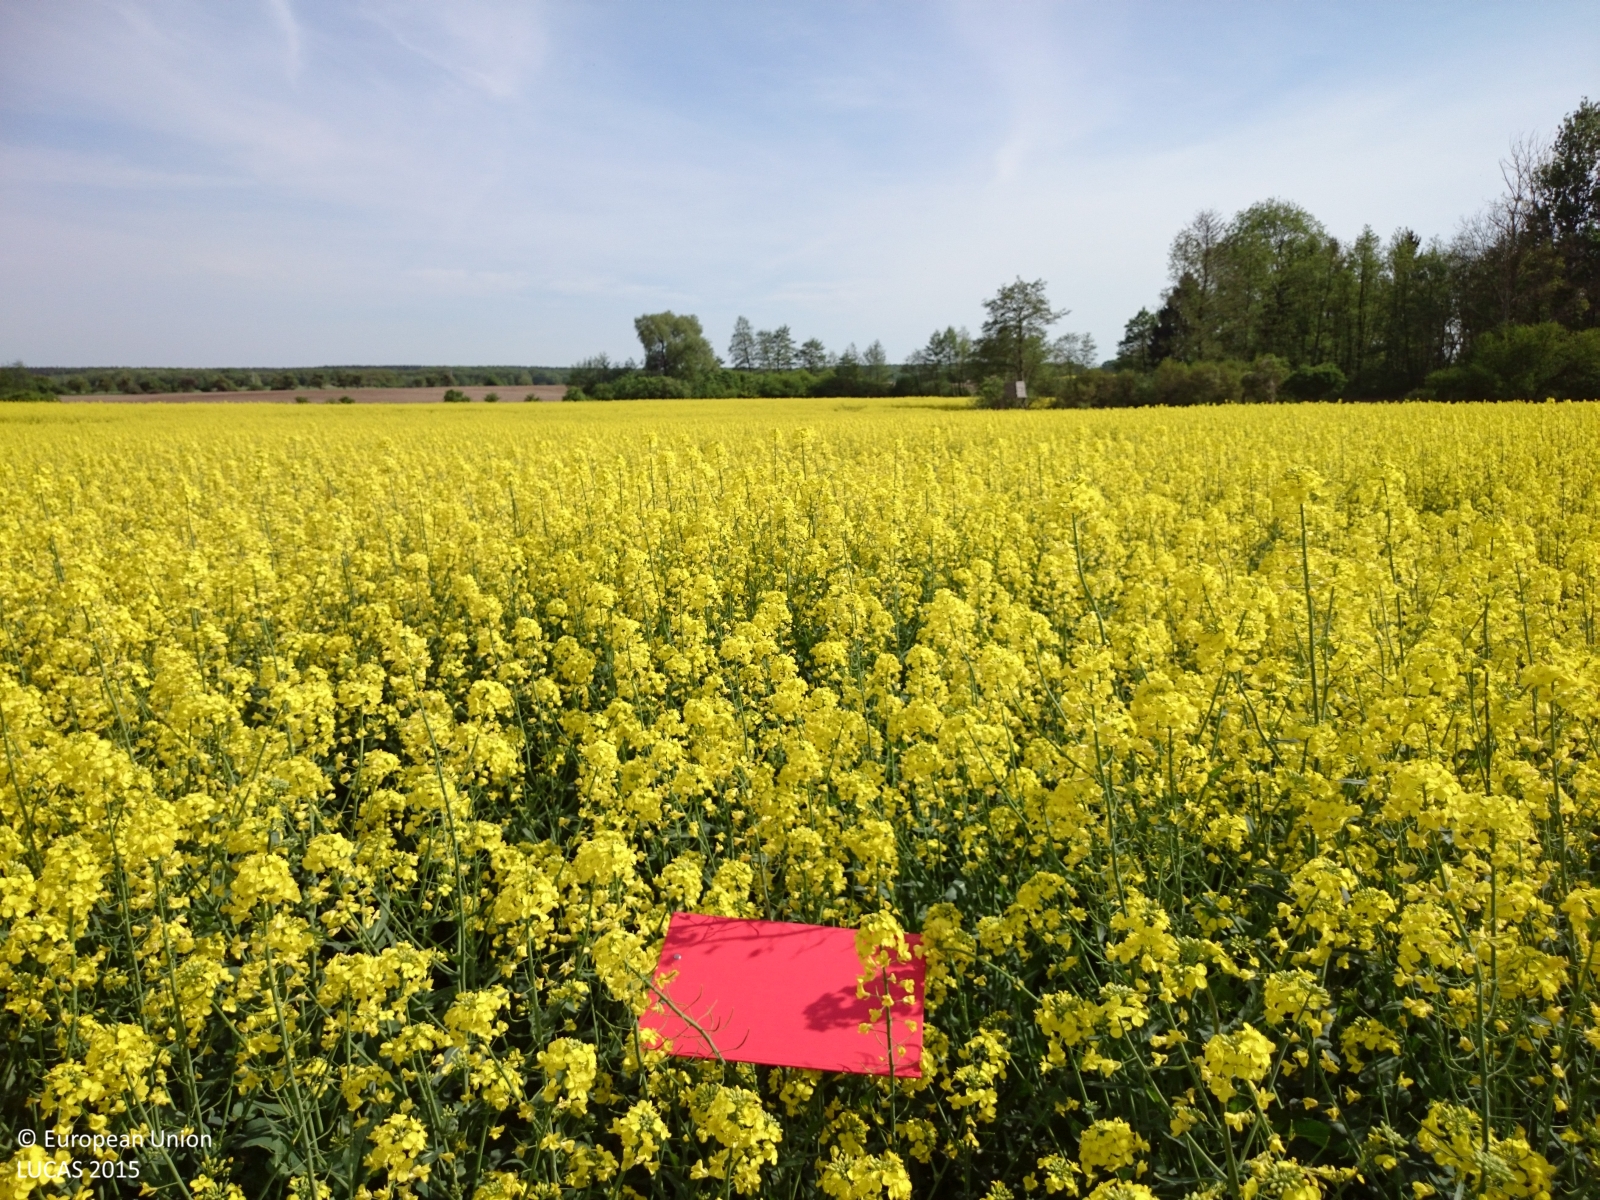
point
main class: Cropland
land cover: Rape and turnip rape
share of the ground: > 75 %
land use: Agriculture (excluding fallow land and kitchen gardens)
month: May
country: PL
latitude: 52.5704
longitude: 16.3068
